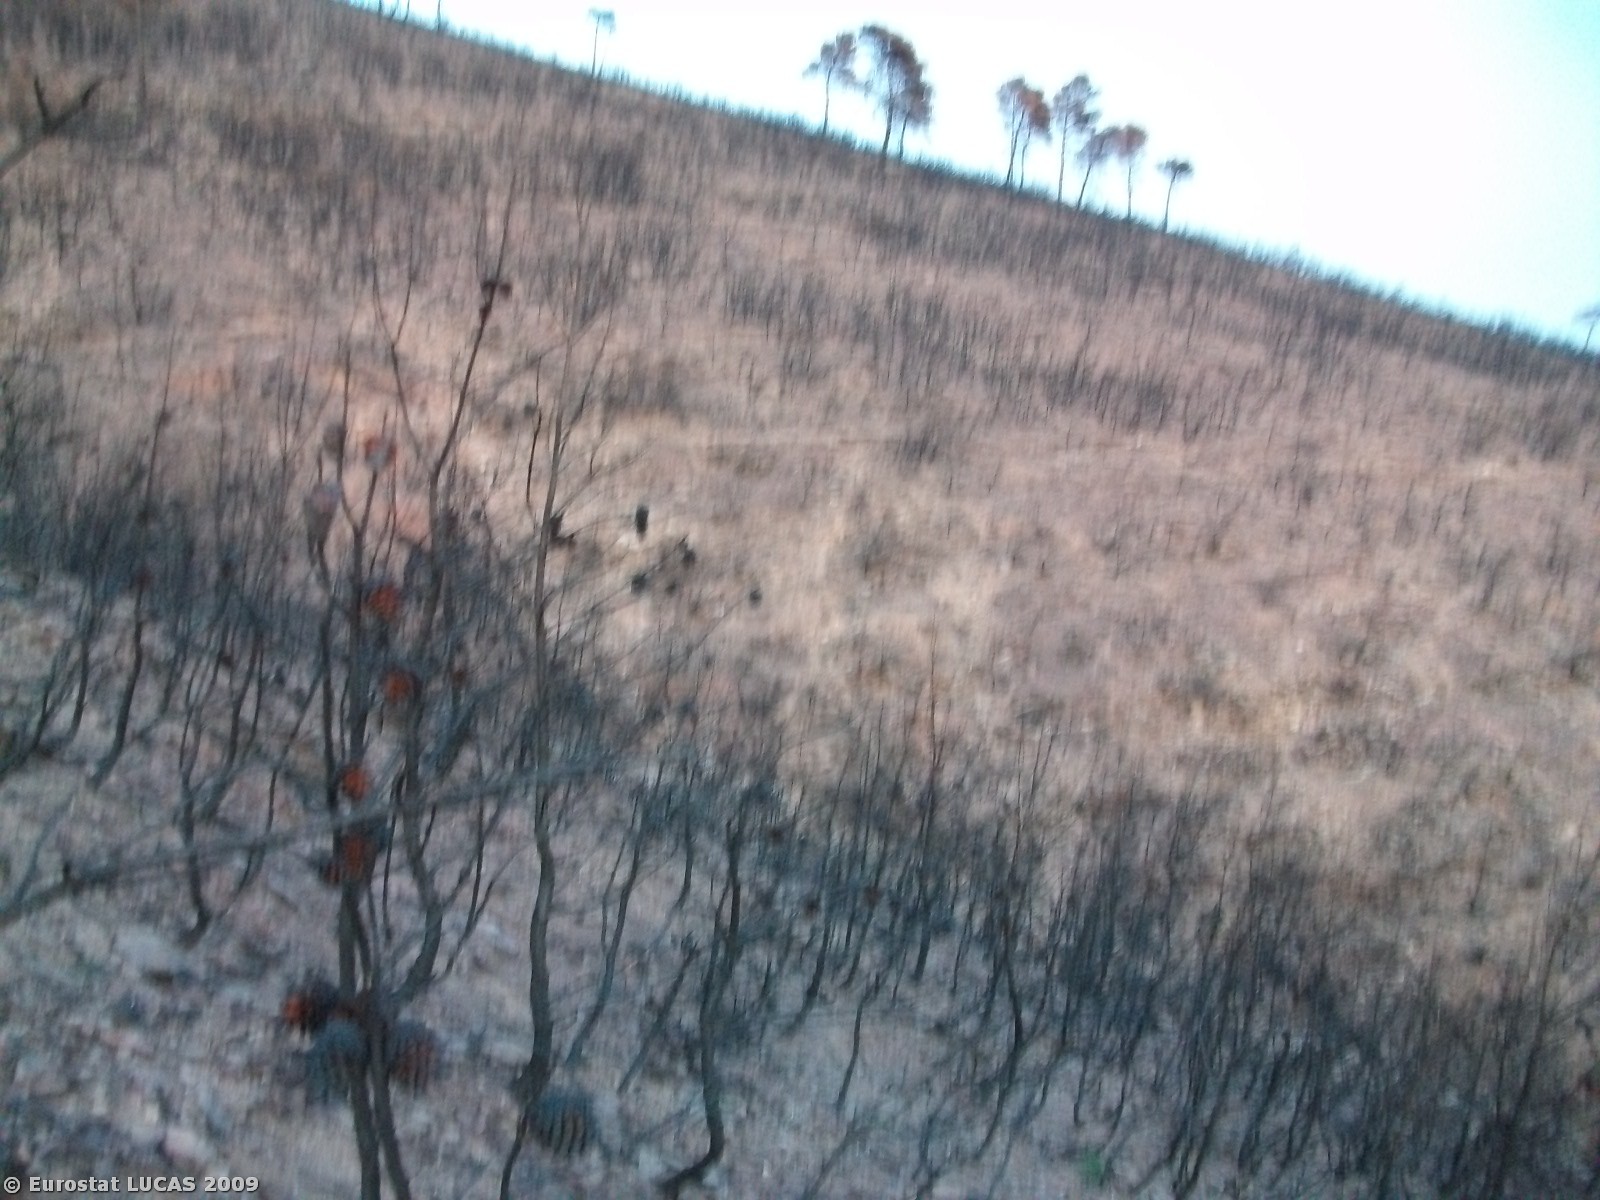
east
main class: Bare land
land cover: Bare land
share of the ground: > 75 %
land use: Forestry
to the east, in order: Bare land; Coniferous woodland
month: October
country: GR
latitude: 38.0408
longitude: 23.9187
